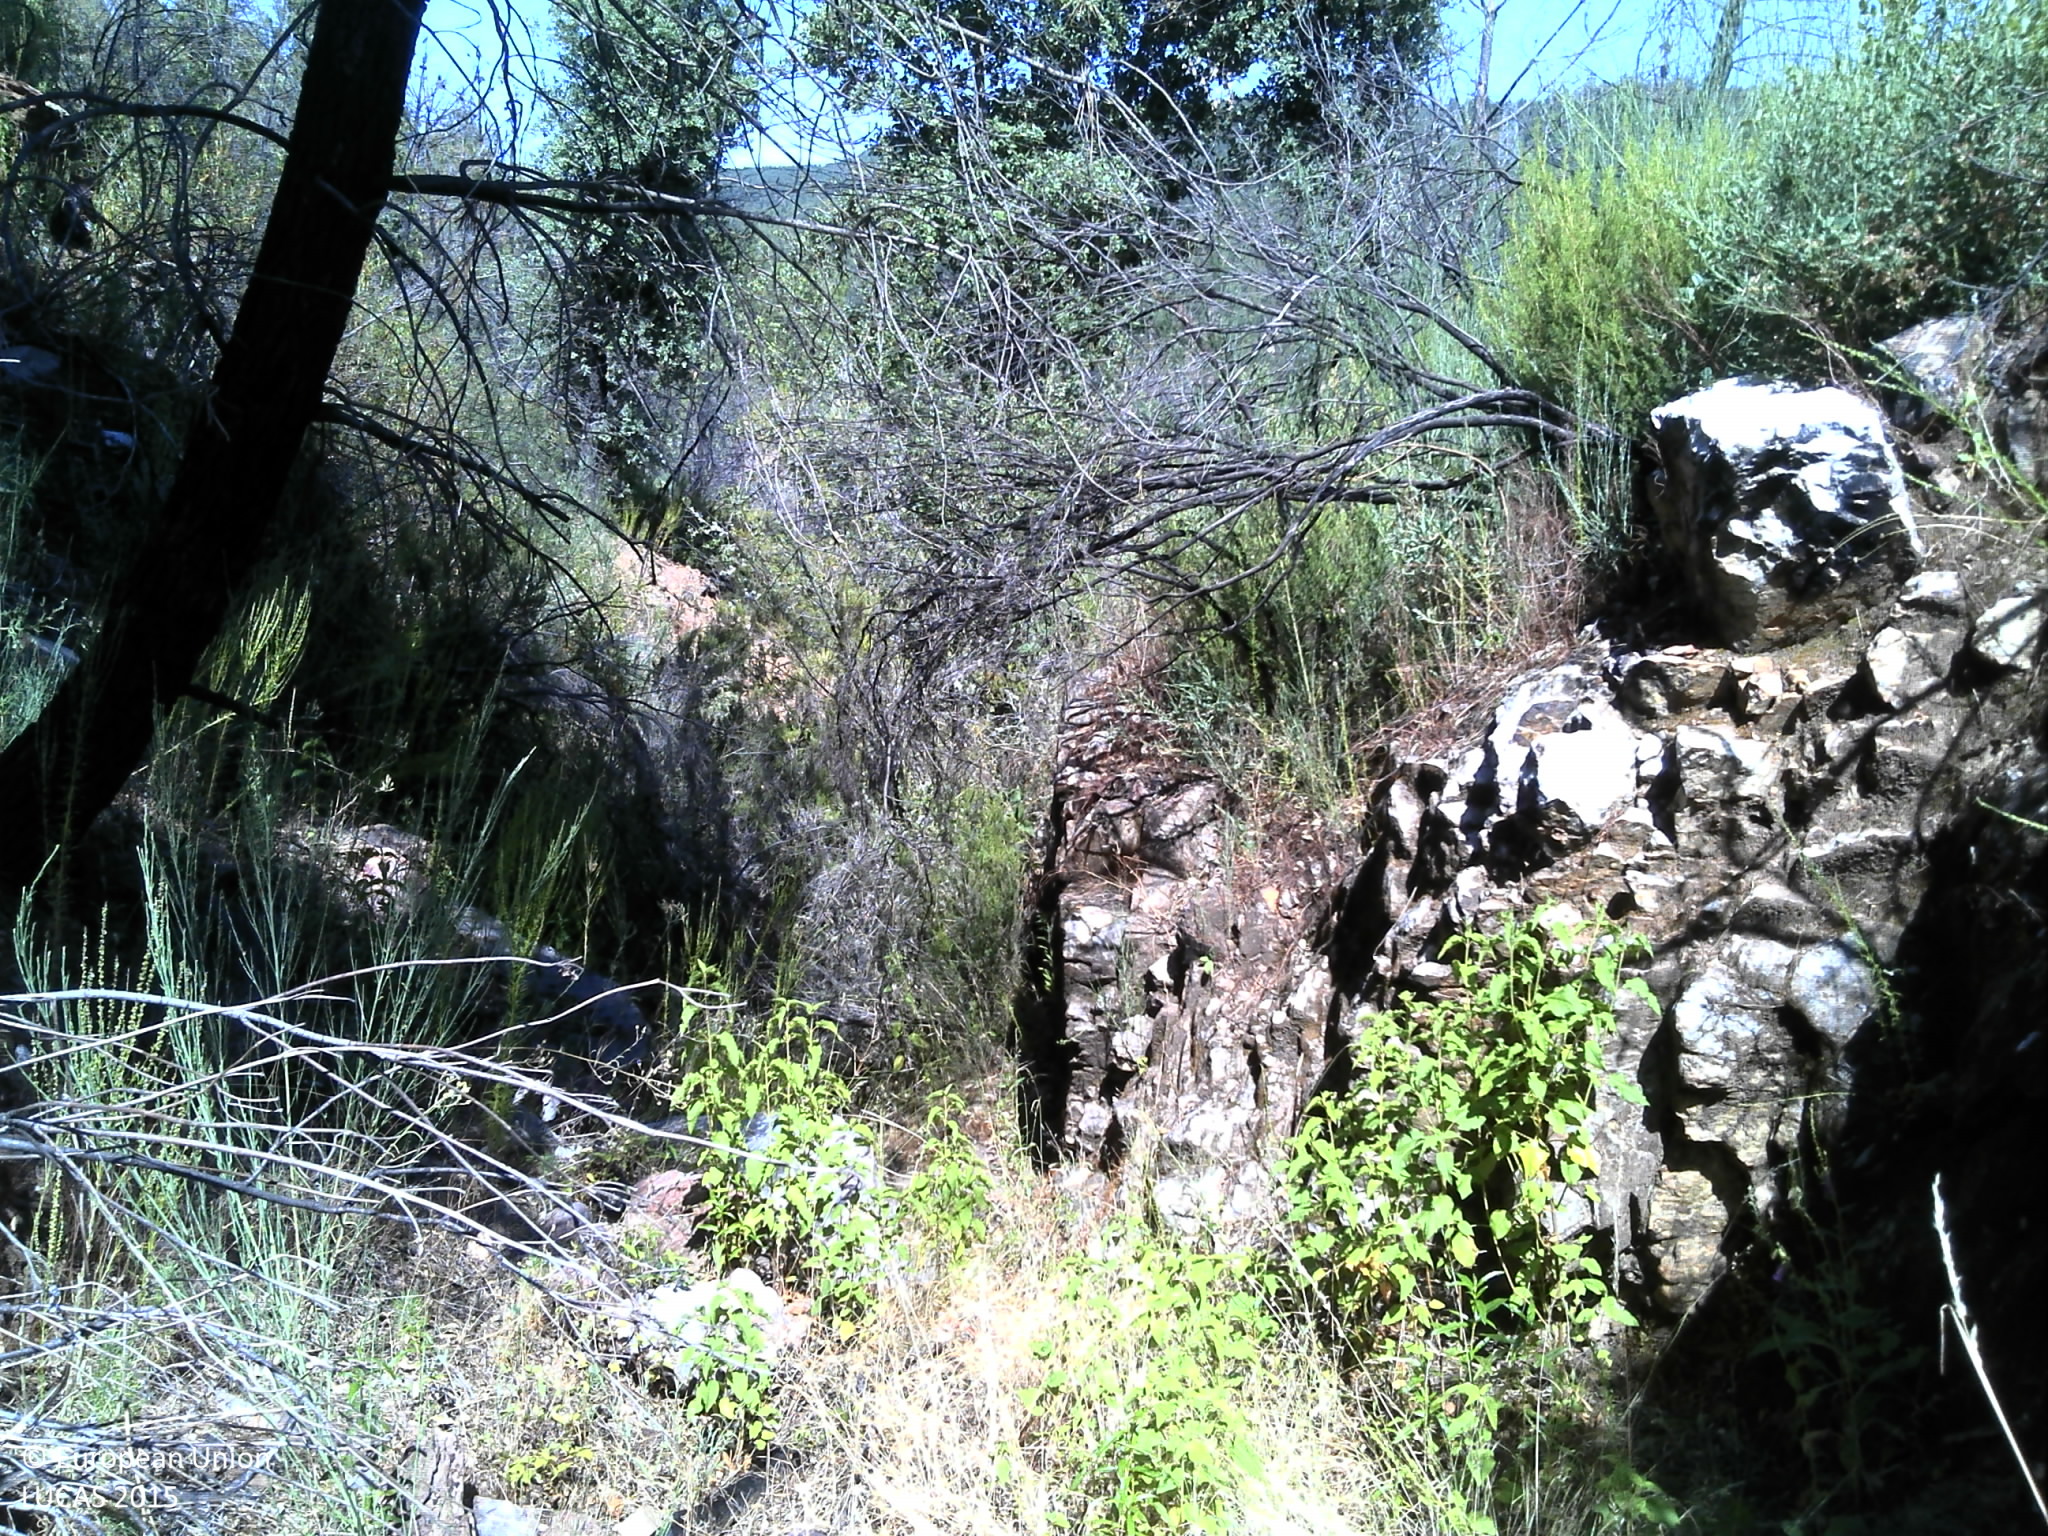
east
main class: Woodland
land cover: Pine dominated coniferous woodland
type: coniferous forest of the mediterranean region
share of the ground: < 10 %
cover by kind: shrubs 80 %, coniferous forest trees 10 %, herbaceous plants 5 %, unconsolidated bare surface 5 %
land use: Abandoned areas
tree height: > 5 m
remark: Burnt area
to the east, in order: Pine dominated coniferous woodland; Rivers and streams; Shrubland with sparse tree cover; Shrubland without tree cover; Tracks; Broadleaved woodland; Tracks; Abandoned hedges; Tracks; Abandoned hedges; Grassland with sparse tree/shrub cover
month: June
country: PT
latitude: 41.2001
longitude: -6.8119
